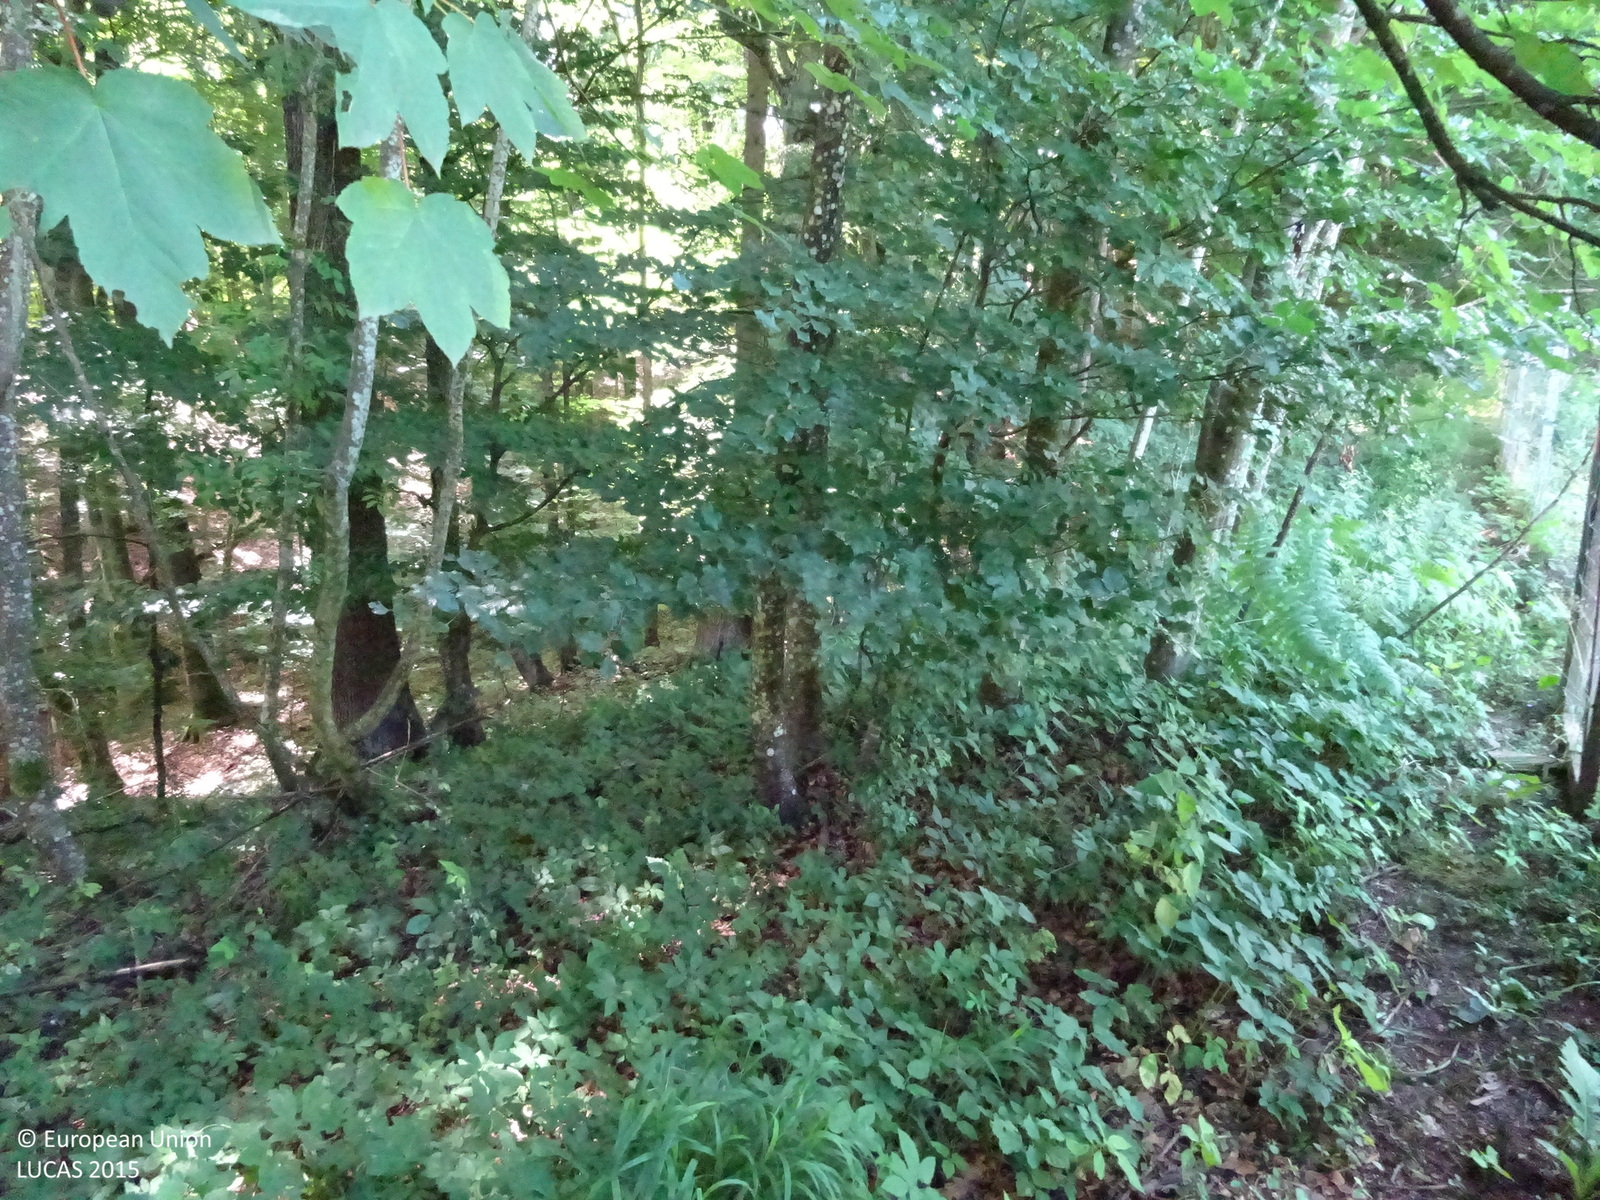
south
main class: Cropland
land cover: Vineyards
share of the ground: 50 - 75 %
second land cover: Grassland without tree/shrub cover
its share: 50 - 75 %
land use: Agriculture (excluding fallow land and kitchen gardens)
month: June
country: AT
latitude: 46.7121
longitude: 15.5588
